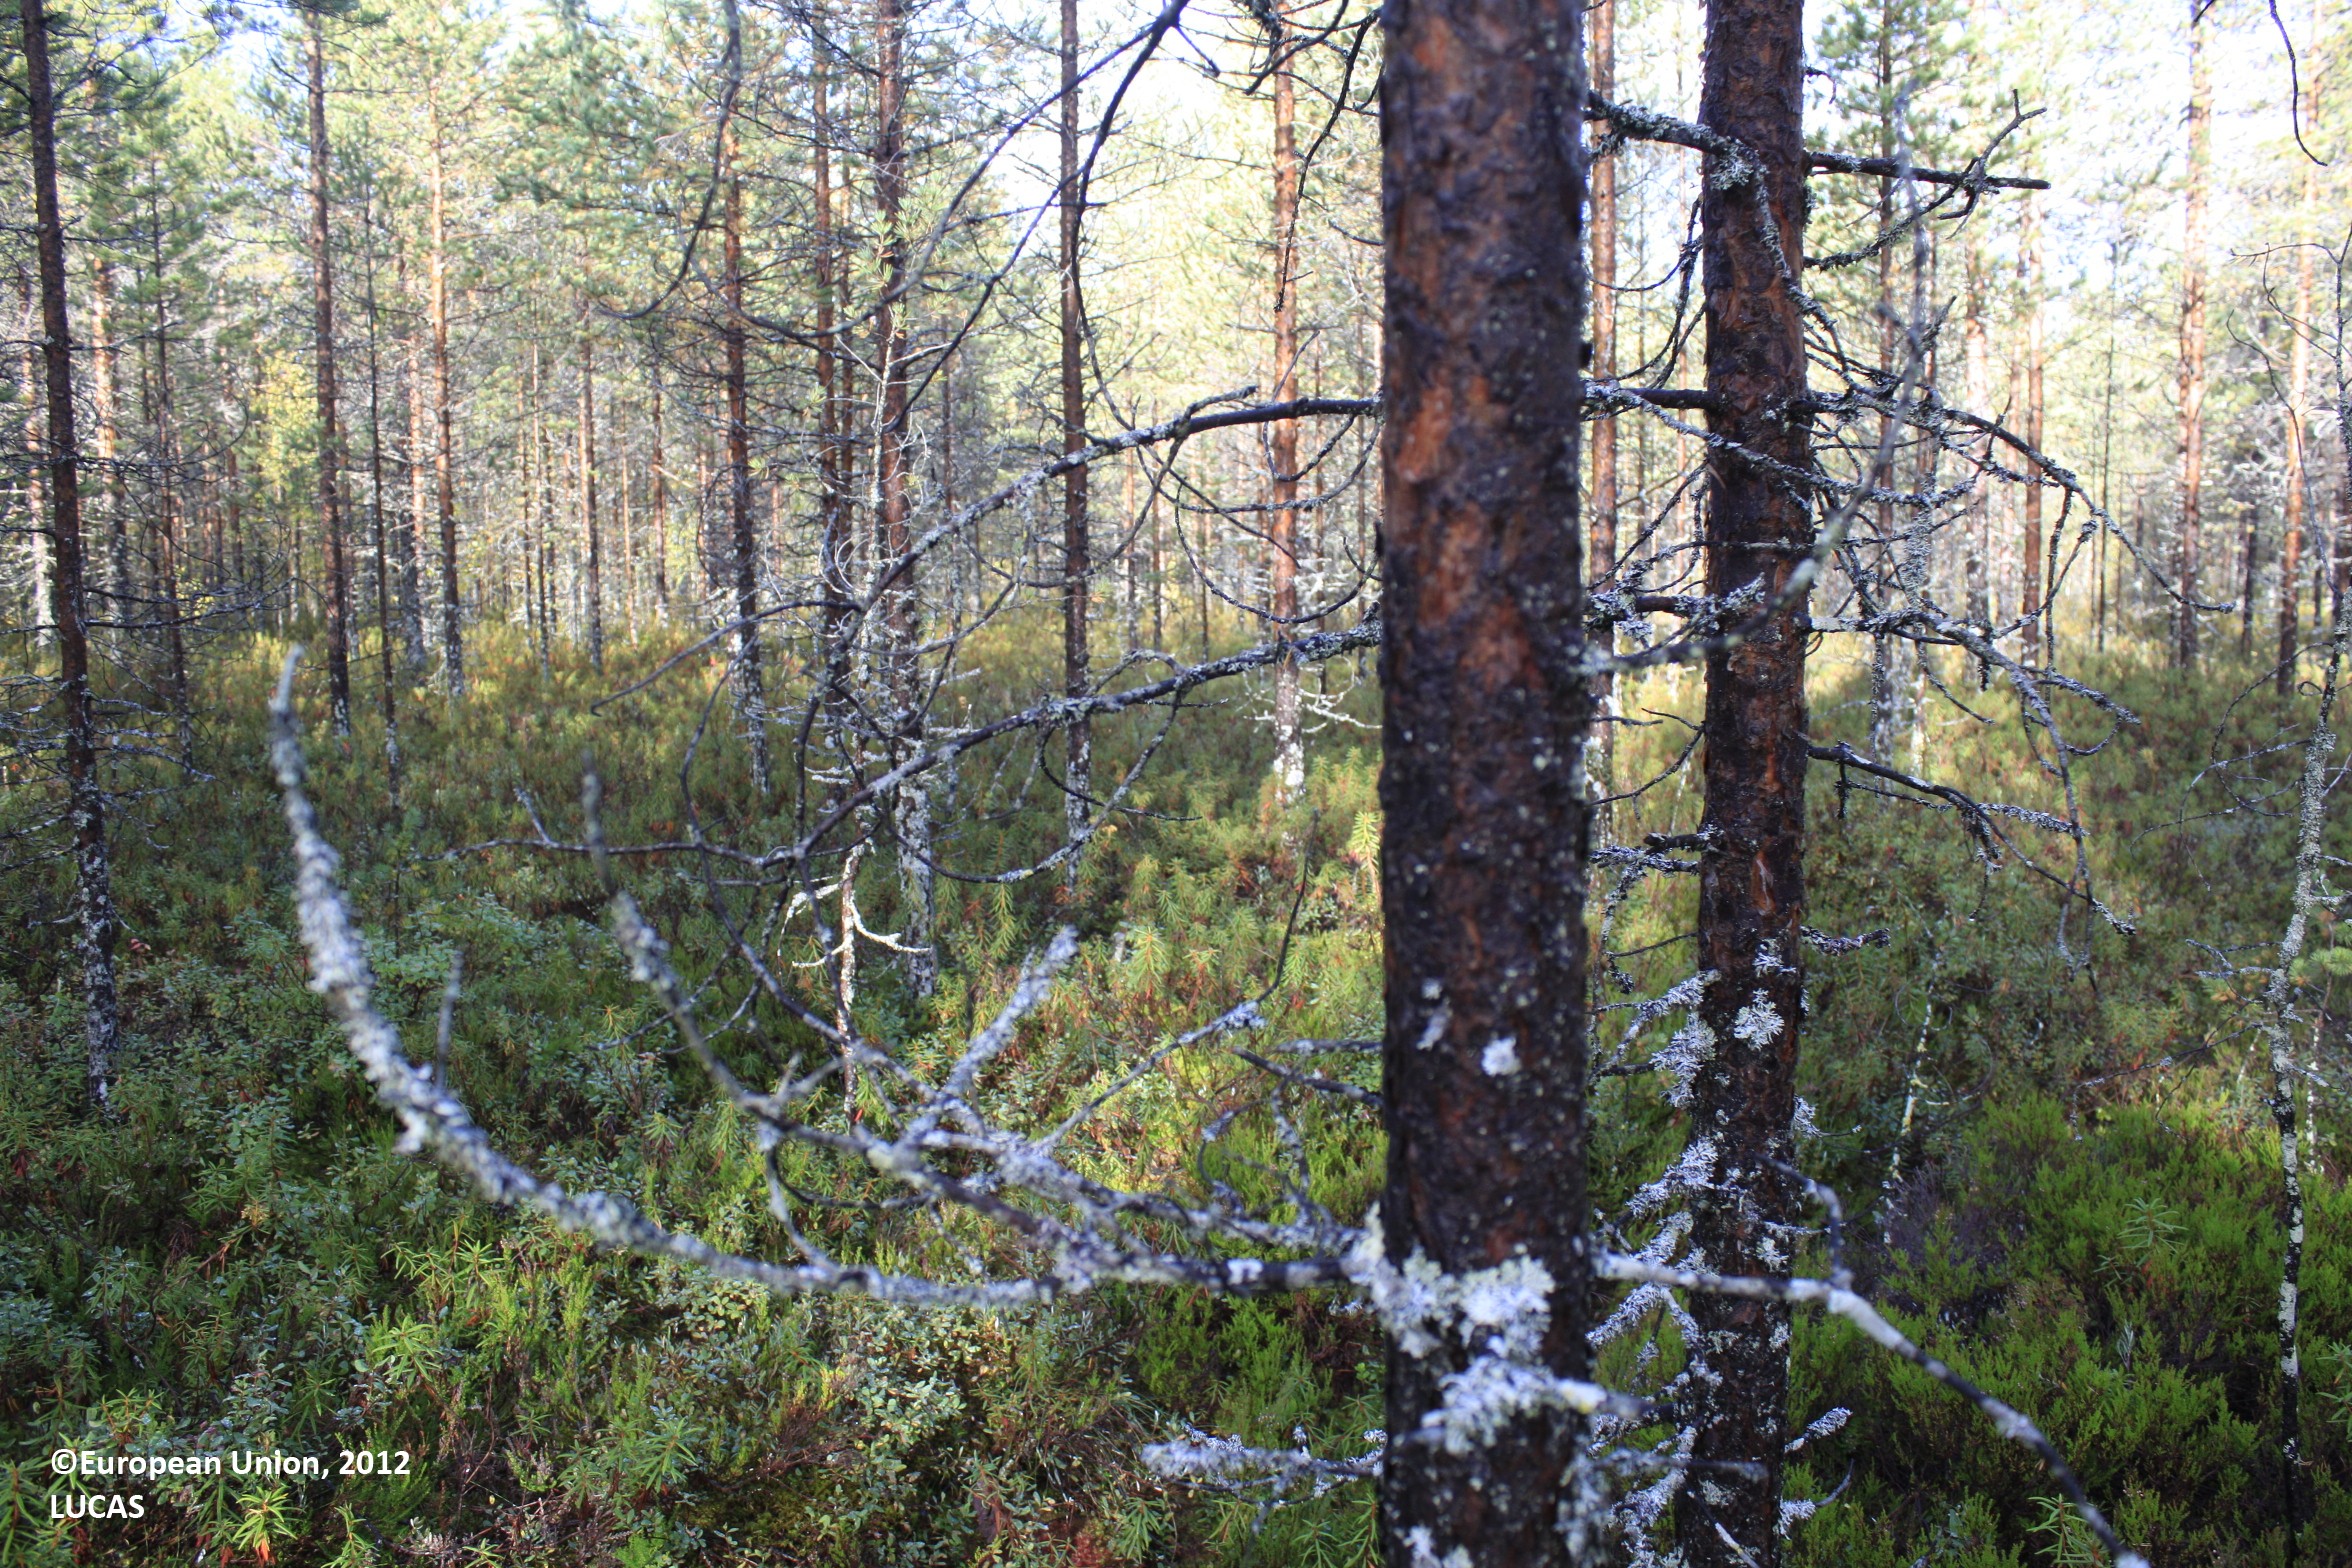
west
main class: Woodland
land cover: Pine dominated coniferous woodland
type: boreal forest
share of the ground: 25 - 50 %
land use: Forestry
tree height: > 5 m
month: September
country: FI
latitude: 65.2664
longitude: 27.0632
